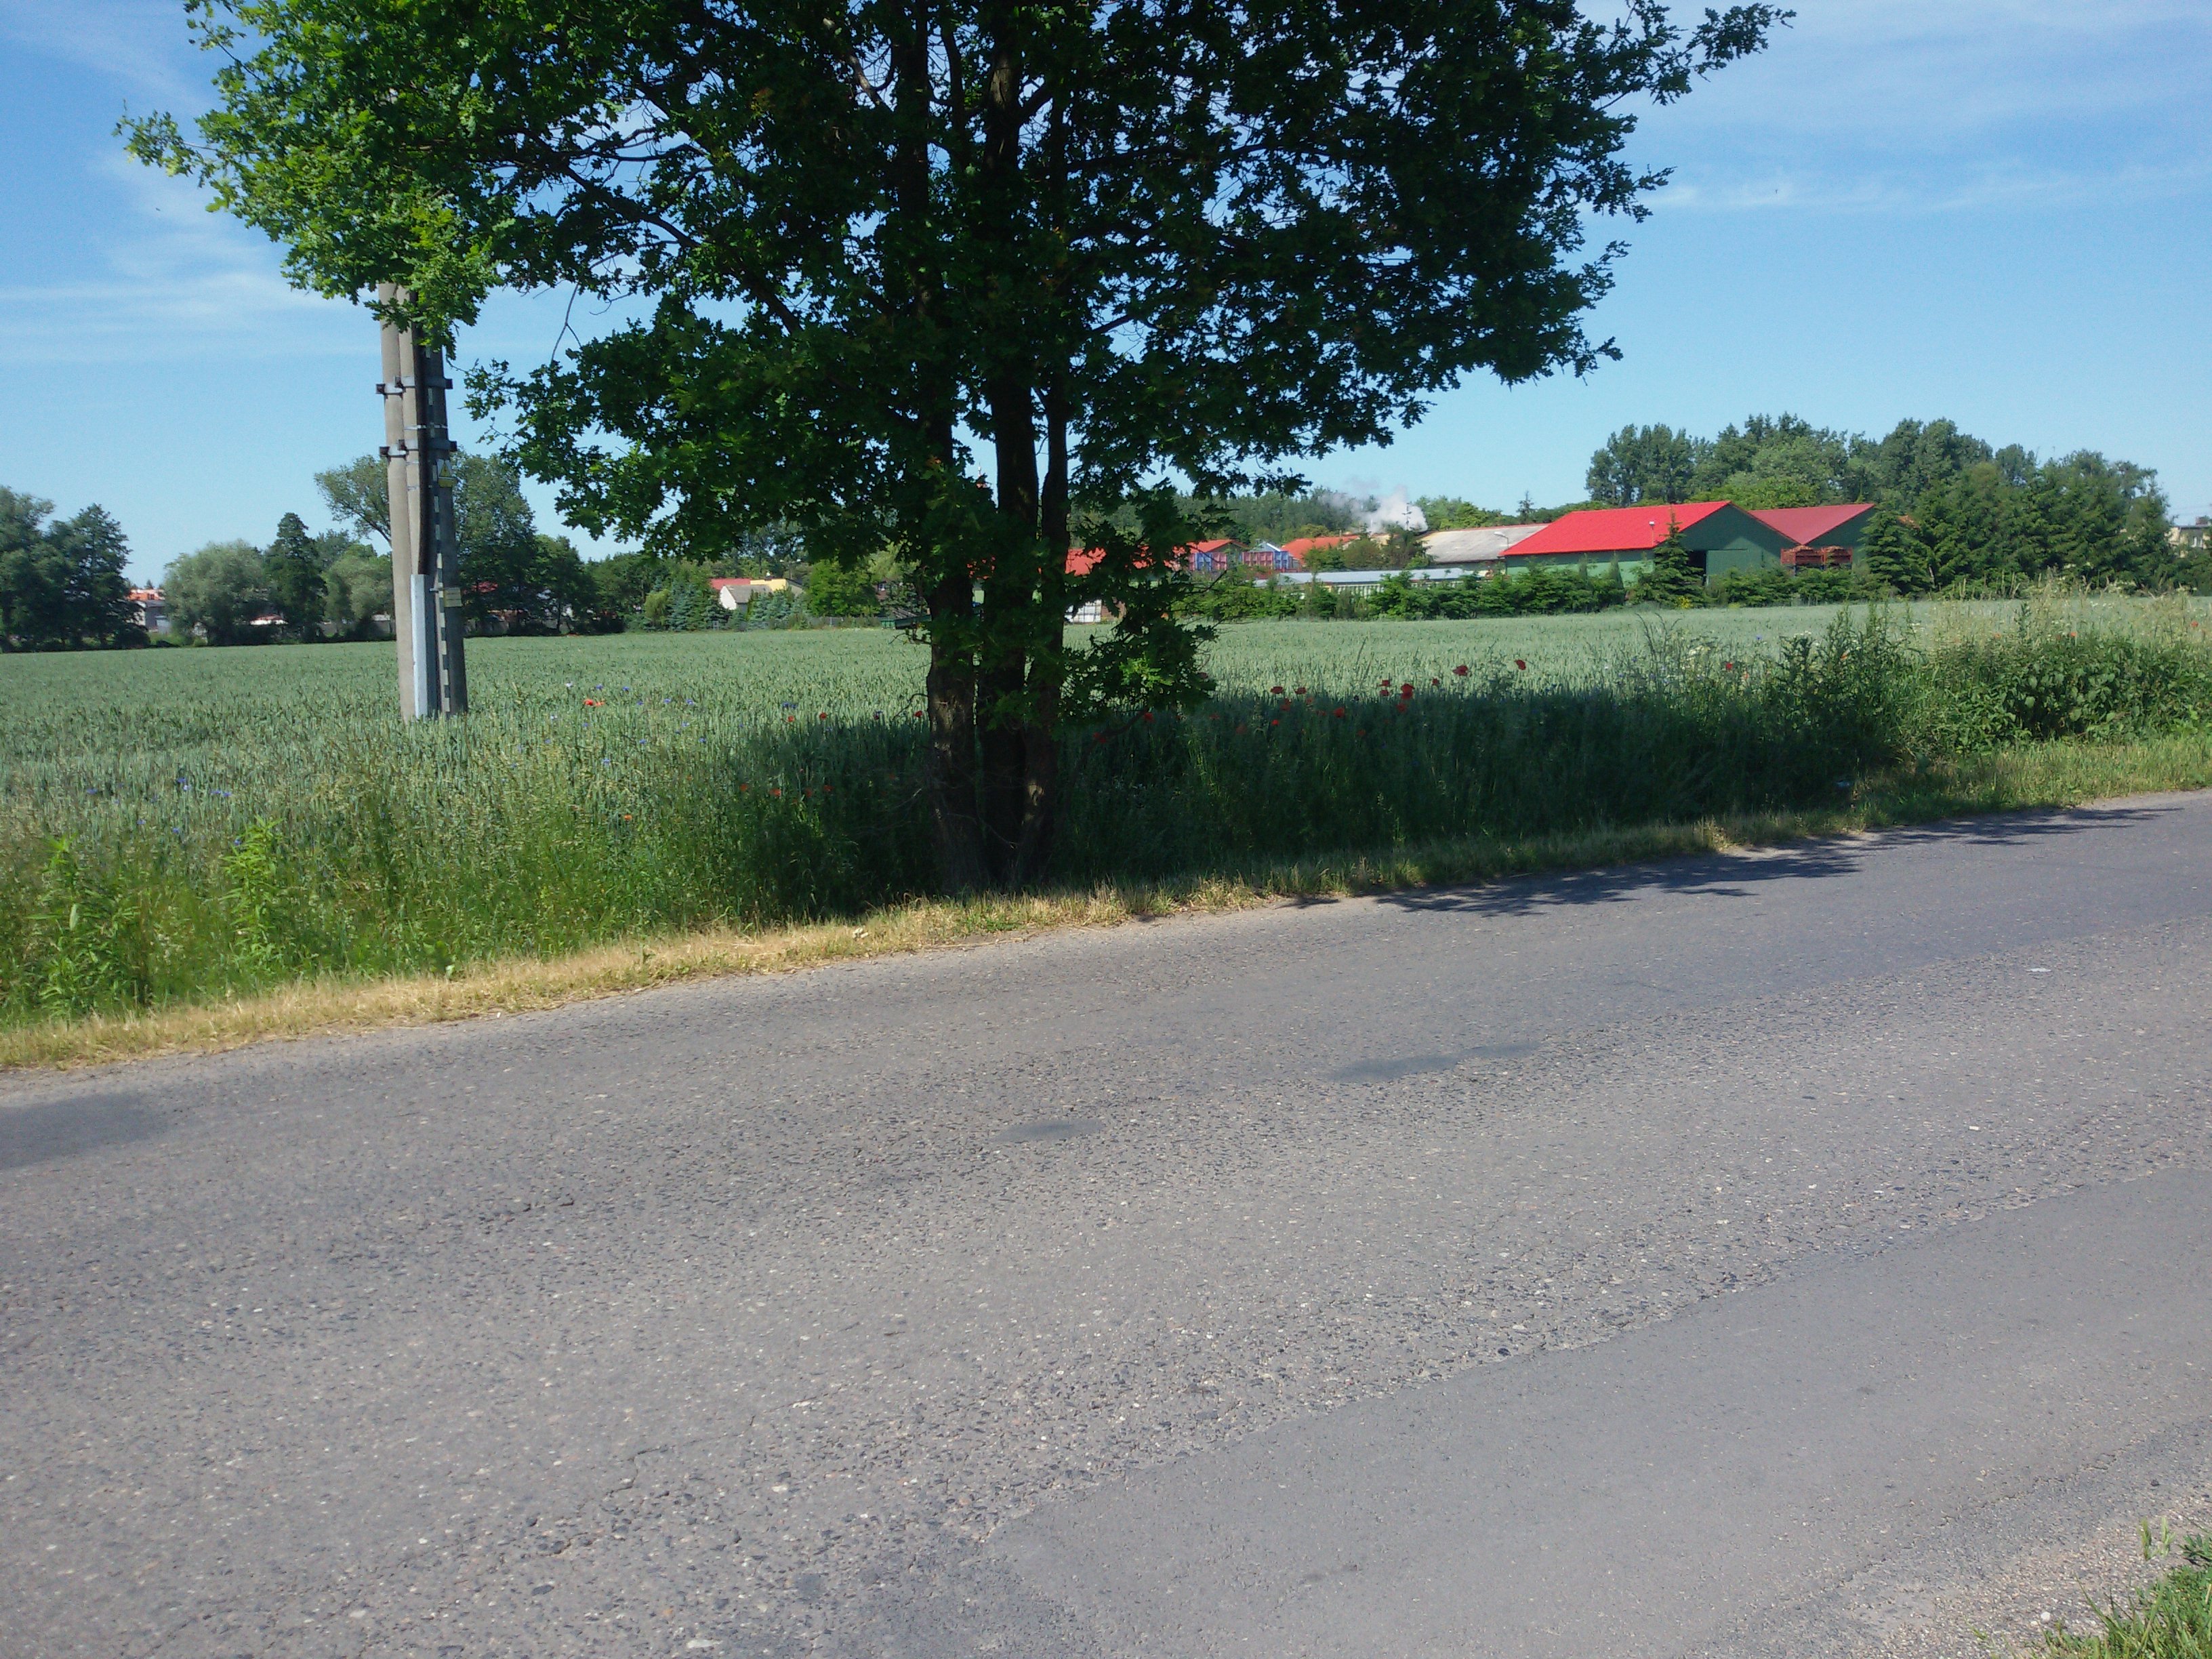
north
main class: Cropland
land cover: Rape and turnip rape
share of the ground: > 75 %
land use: Agriculture (excluding fallow land and kitchen gardens)
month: June
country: PL
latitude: 52.3775
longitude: 17.1647
